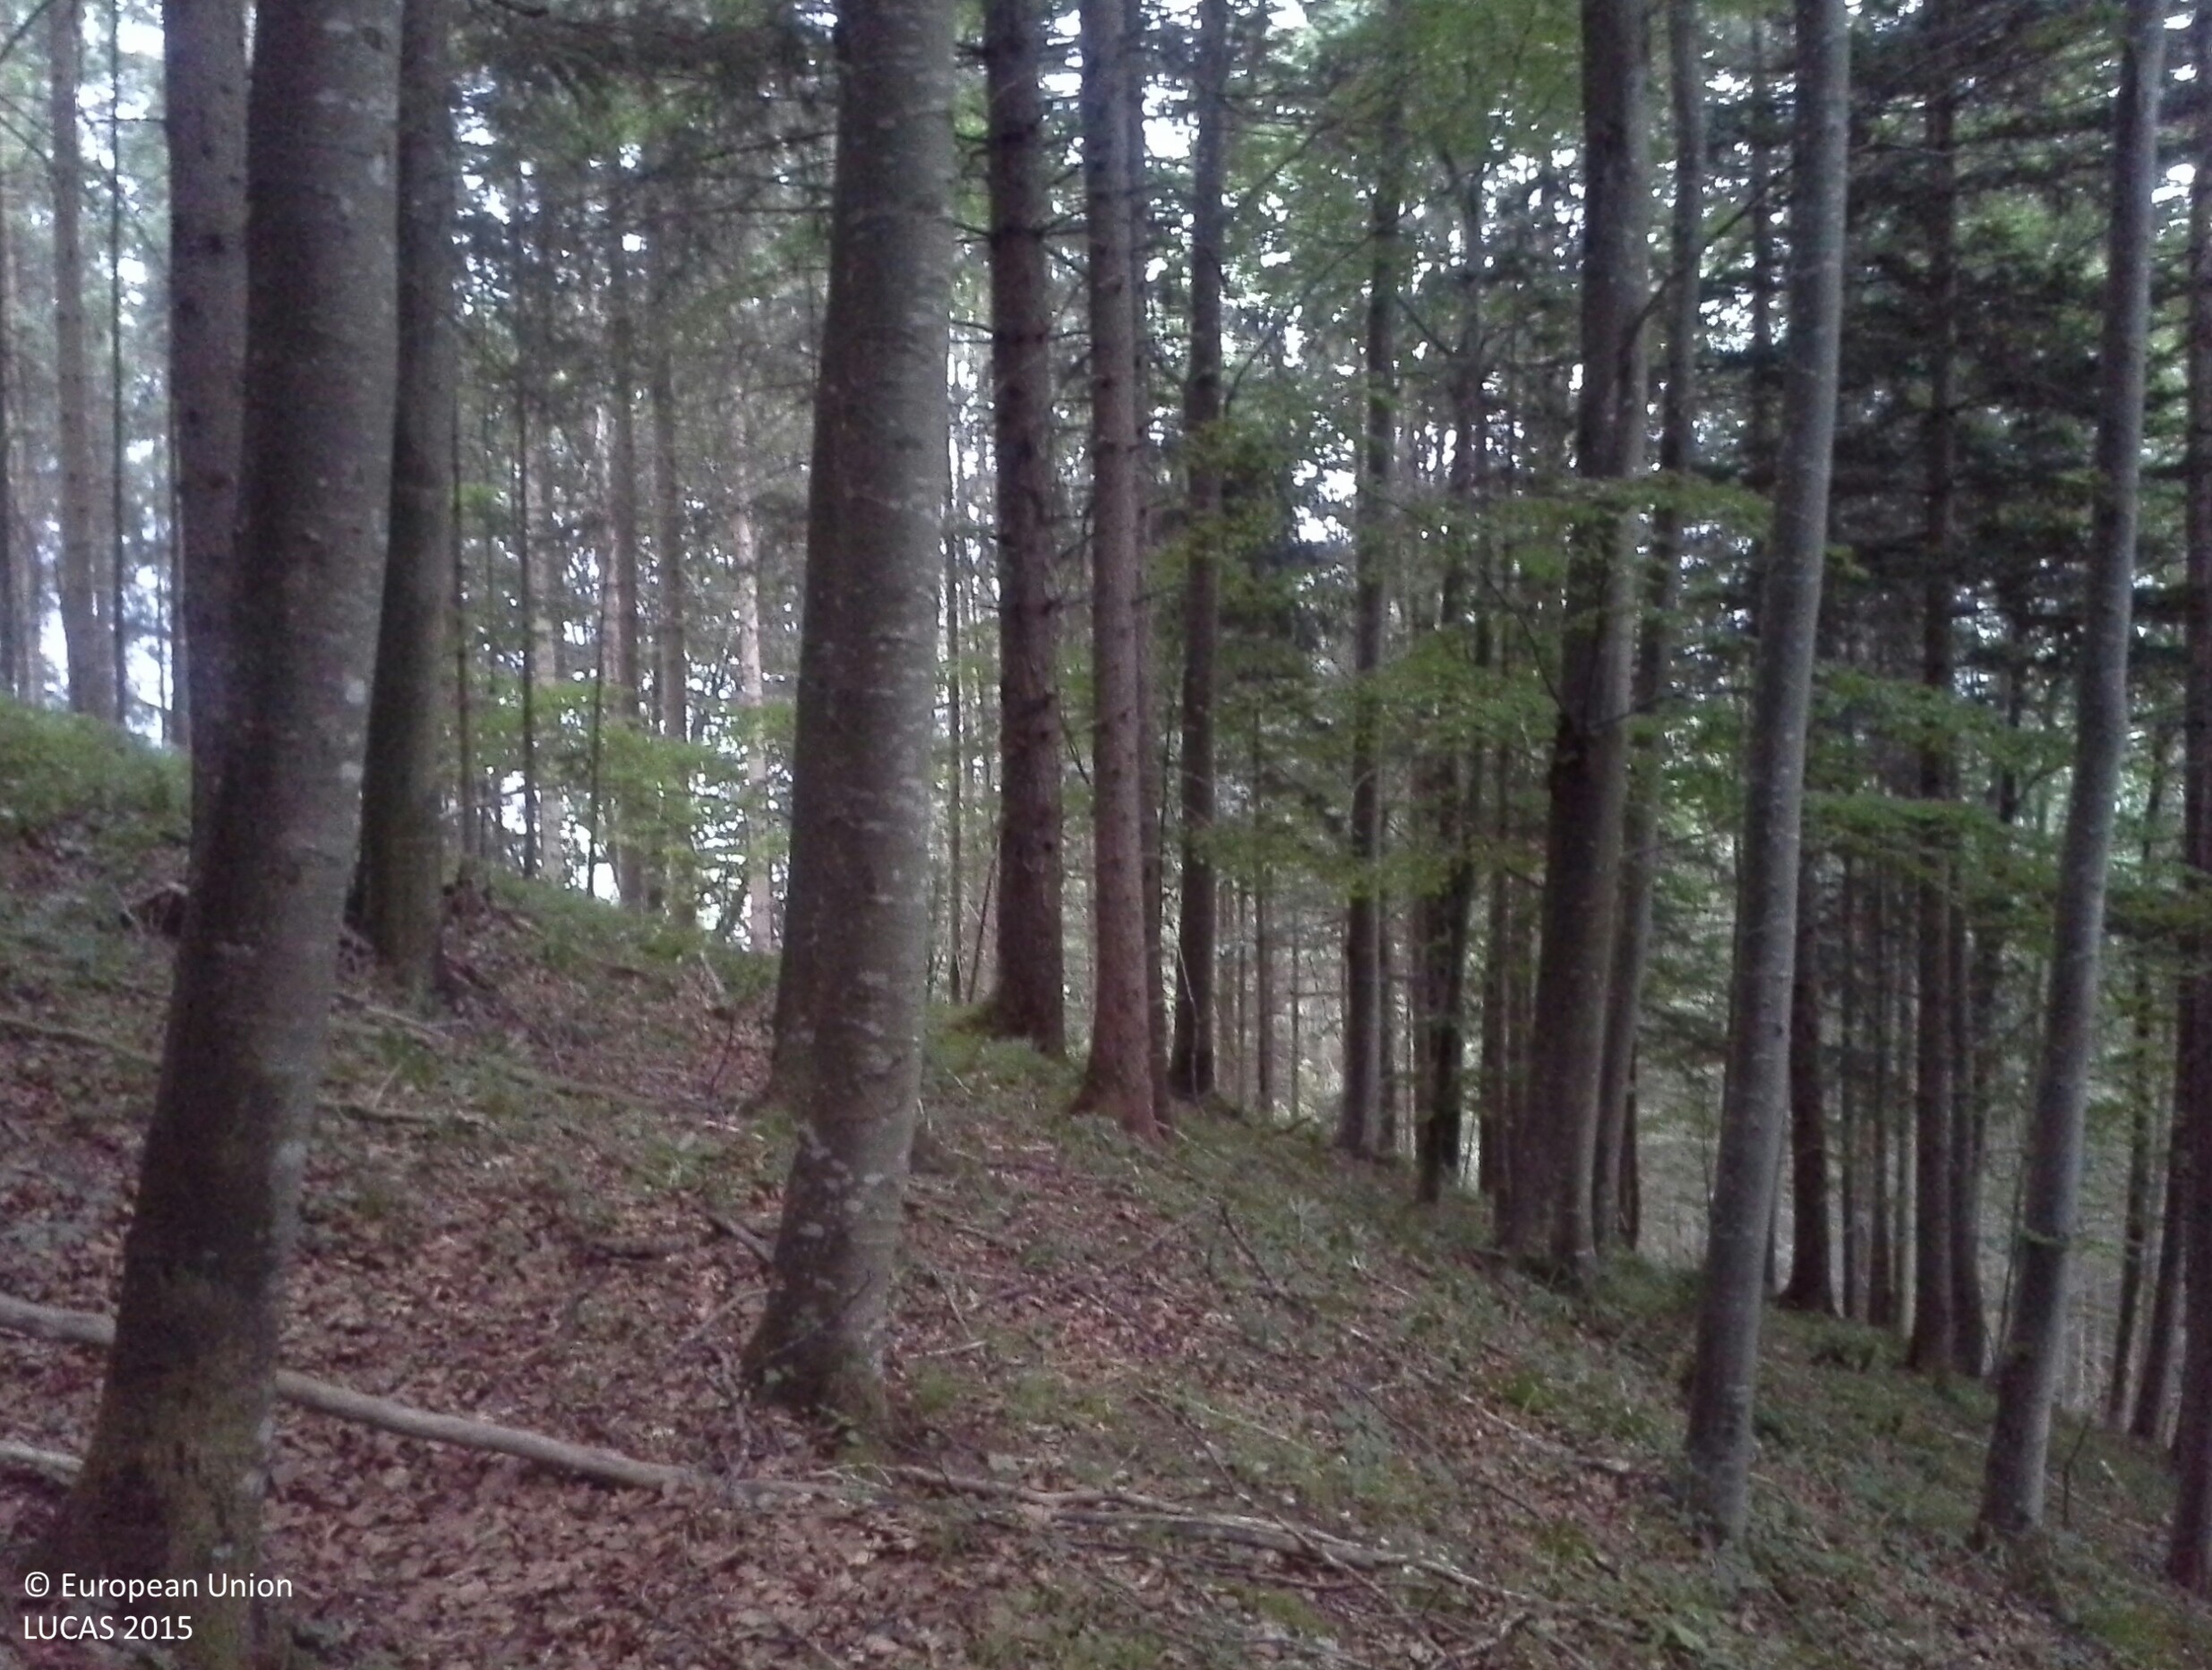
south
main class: Woodland
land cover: Broadleaved woodland
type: beech forest
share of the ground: > 75 %
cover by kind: broadleaved forest trees 80 %, coniferous forest trees 20 %
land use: Forestry
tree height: > 5 m
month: July
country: AT
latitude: 47.8533
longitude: 14.6911
